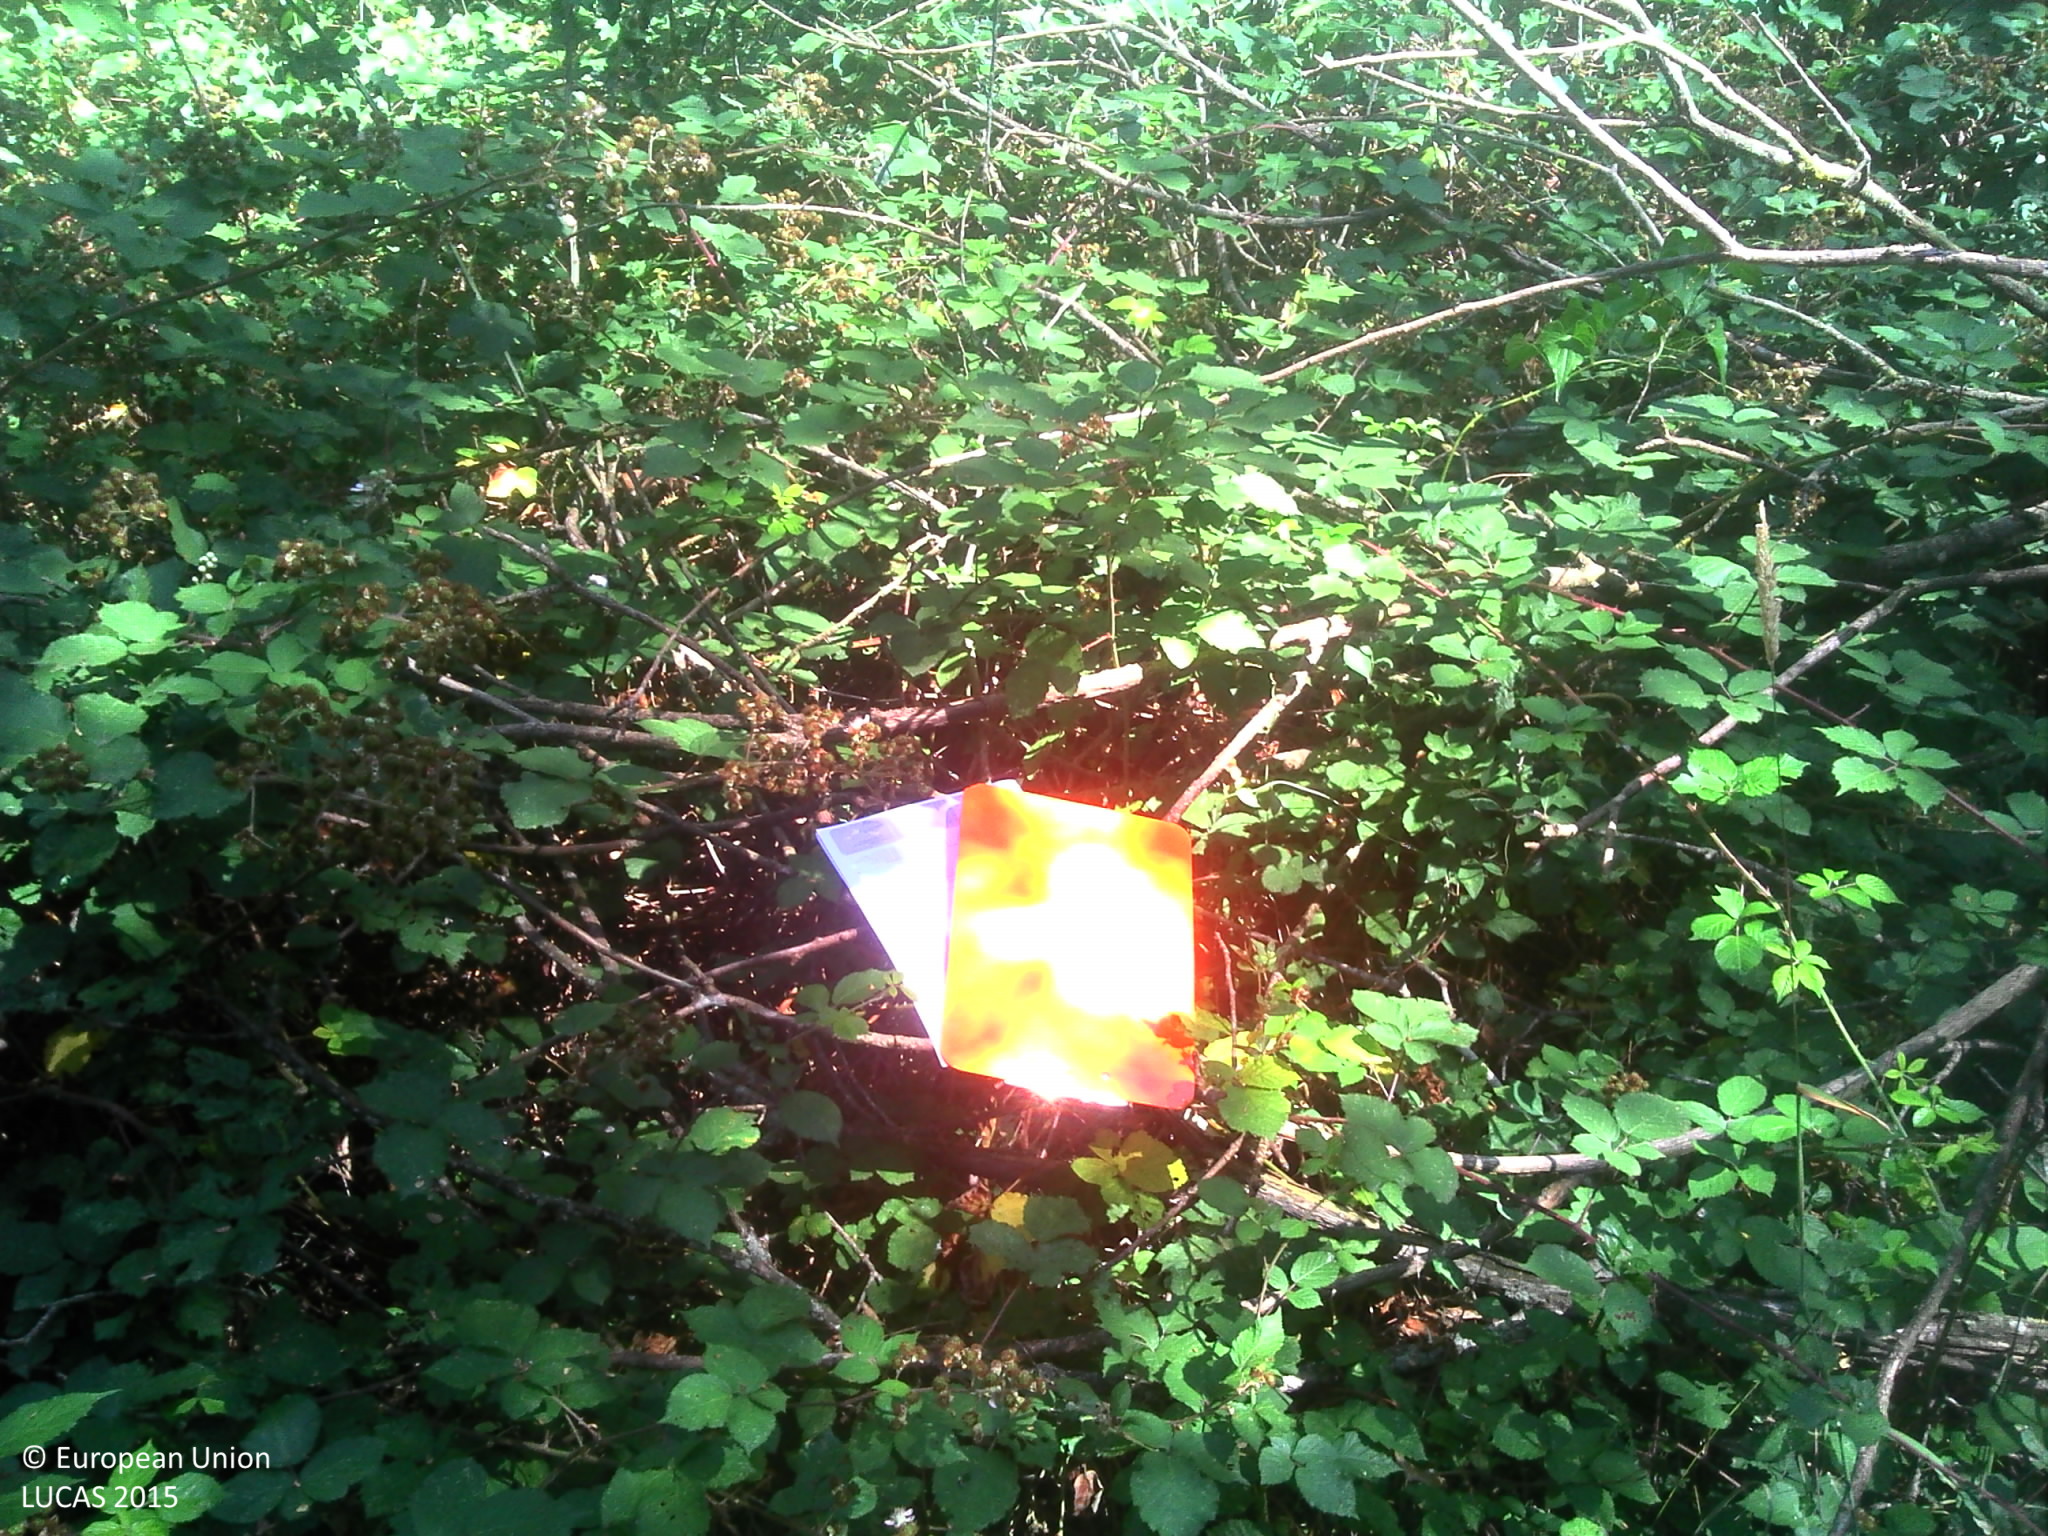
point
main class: Woodland
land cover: Broadleaved woodland
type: mesophytic deciduous forest
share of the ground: > 75 %
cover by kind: herbaceous plants 50 %, broadleaved forest trees 40 %, unconsolidated bare surface 10 %
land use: Forestry
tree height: > 5 m
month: July
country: FR
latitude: 47.9541
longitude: 0.8878
